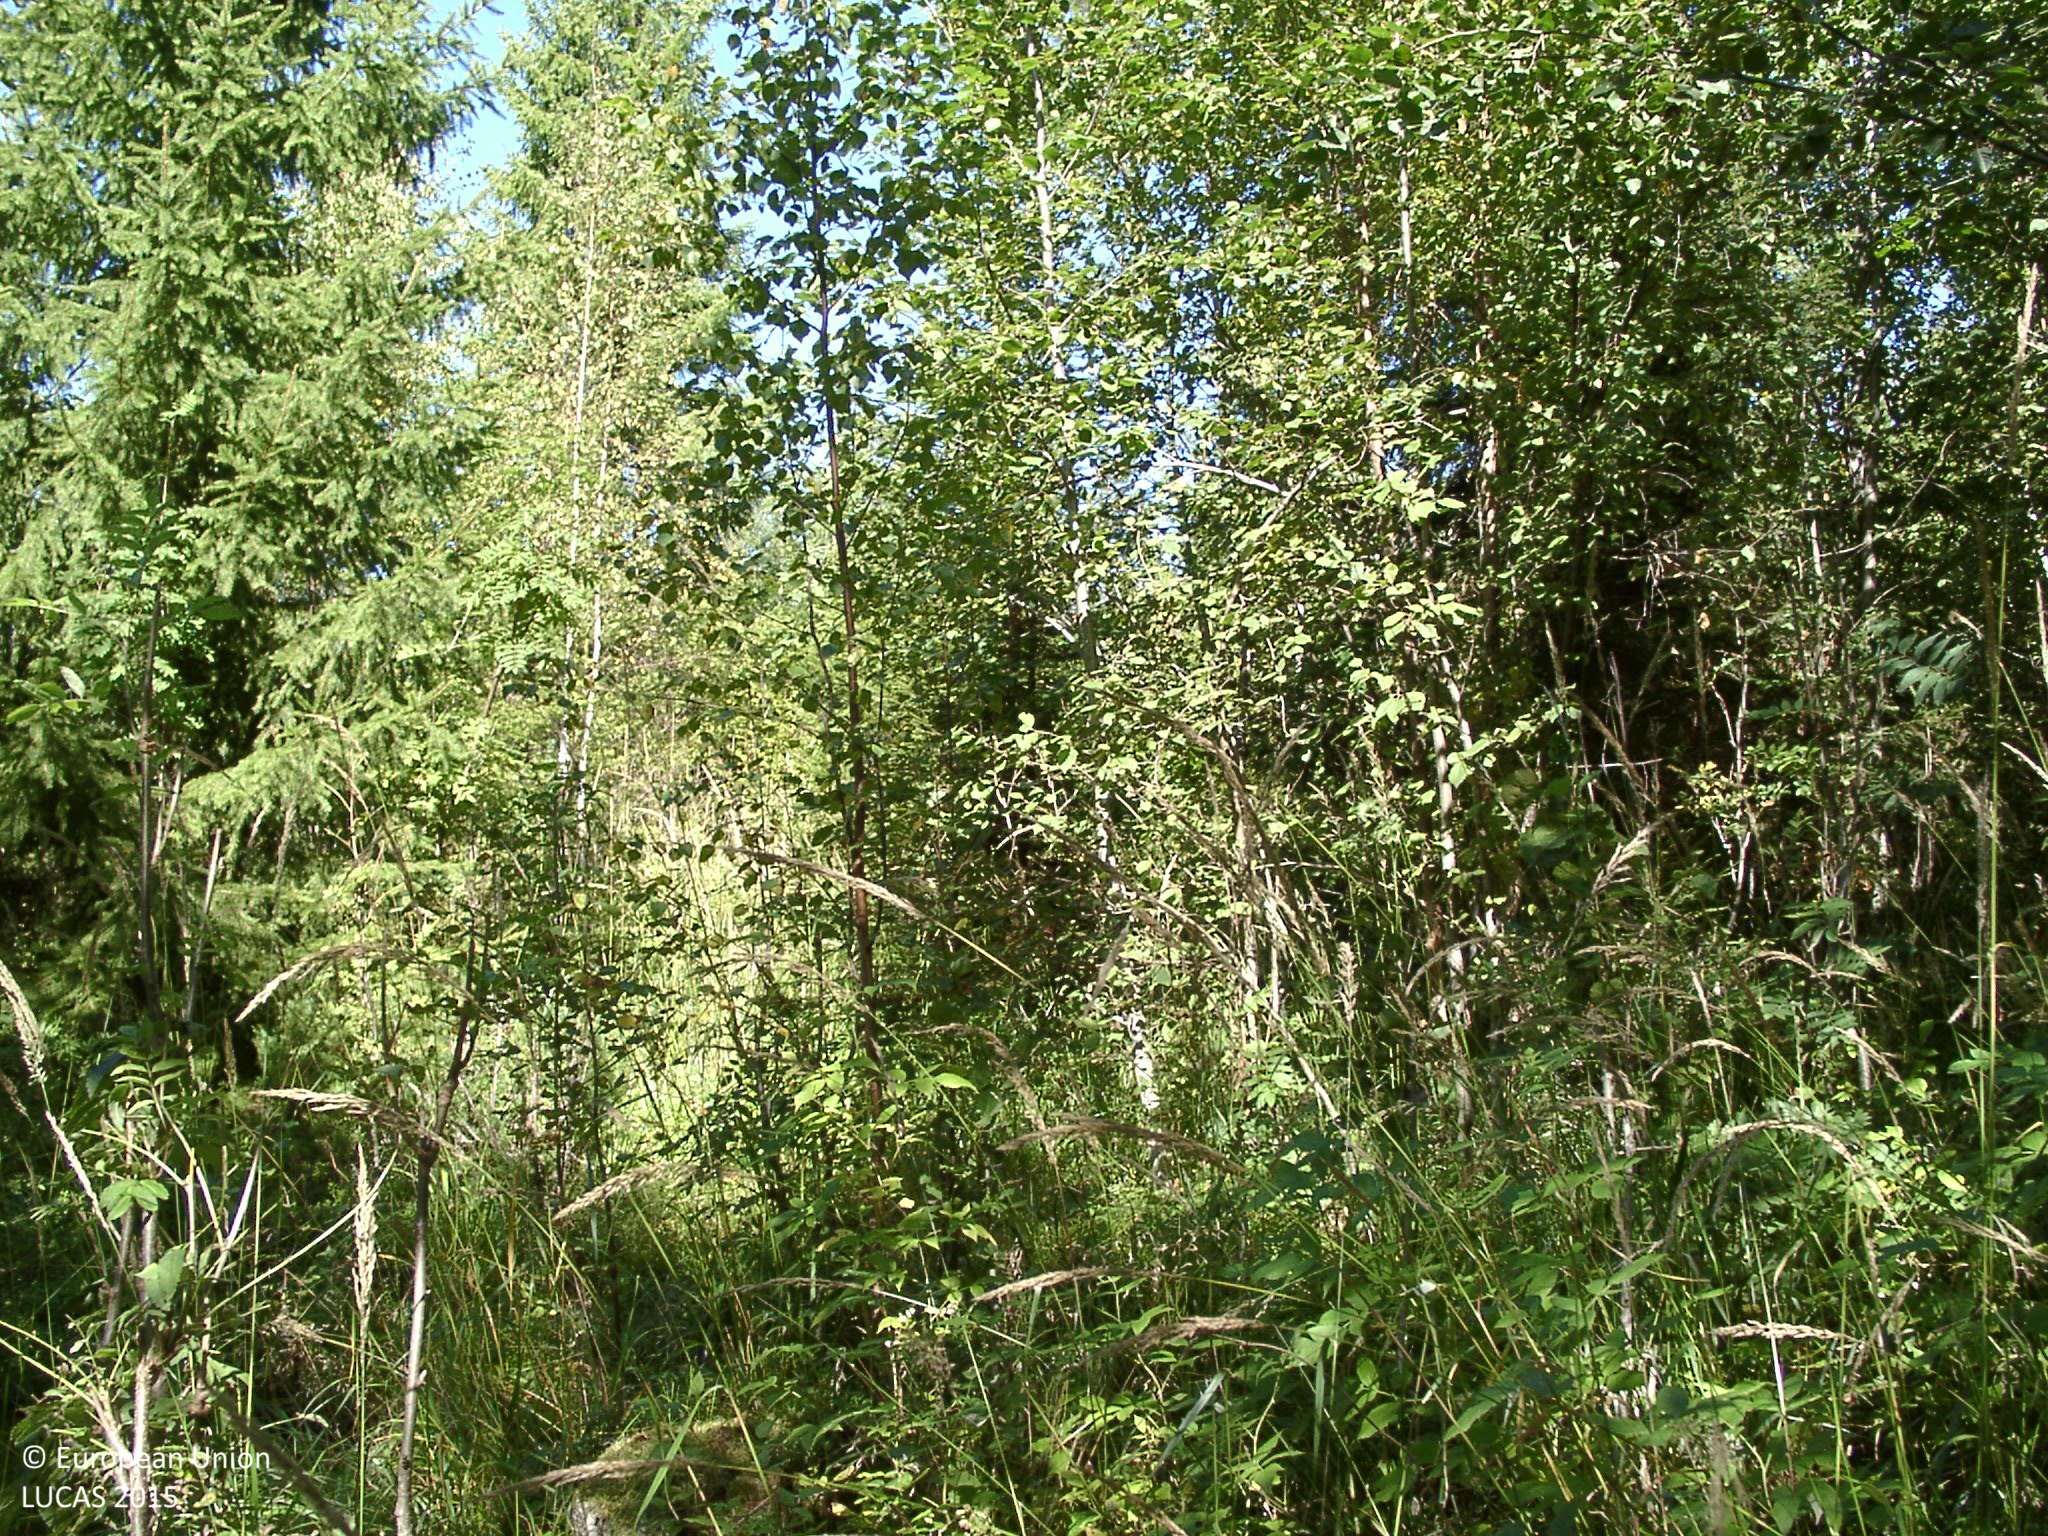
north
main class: Woodland
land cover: Broadleaved woodland
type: boreal forest
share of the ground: 50 - 75 %
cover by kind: broadleaved forest trees 50 %, herbaceous plants 25 %, coniferous forest trees 15 %, shrubs 10 %
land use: Forestry
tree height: < 5 m
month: August
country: FI
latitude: 61.9239
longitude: 24.8635
